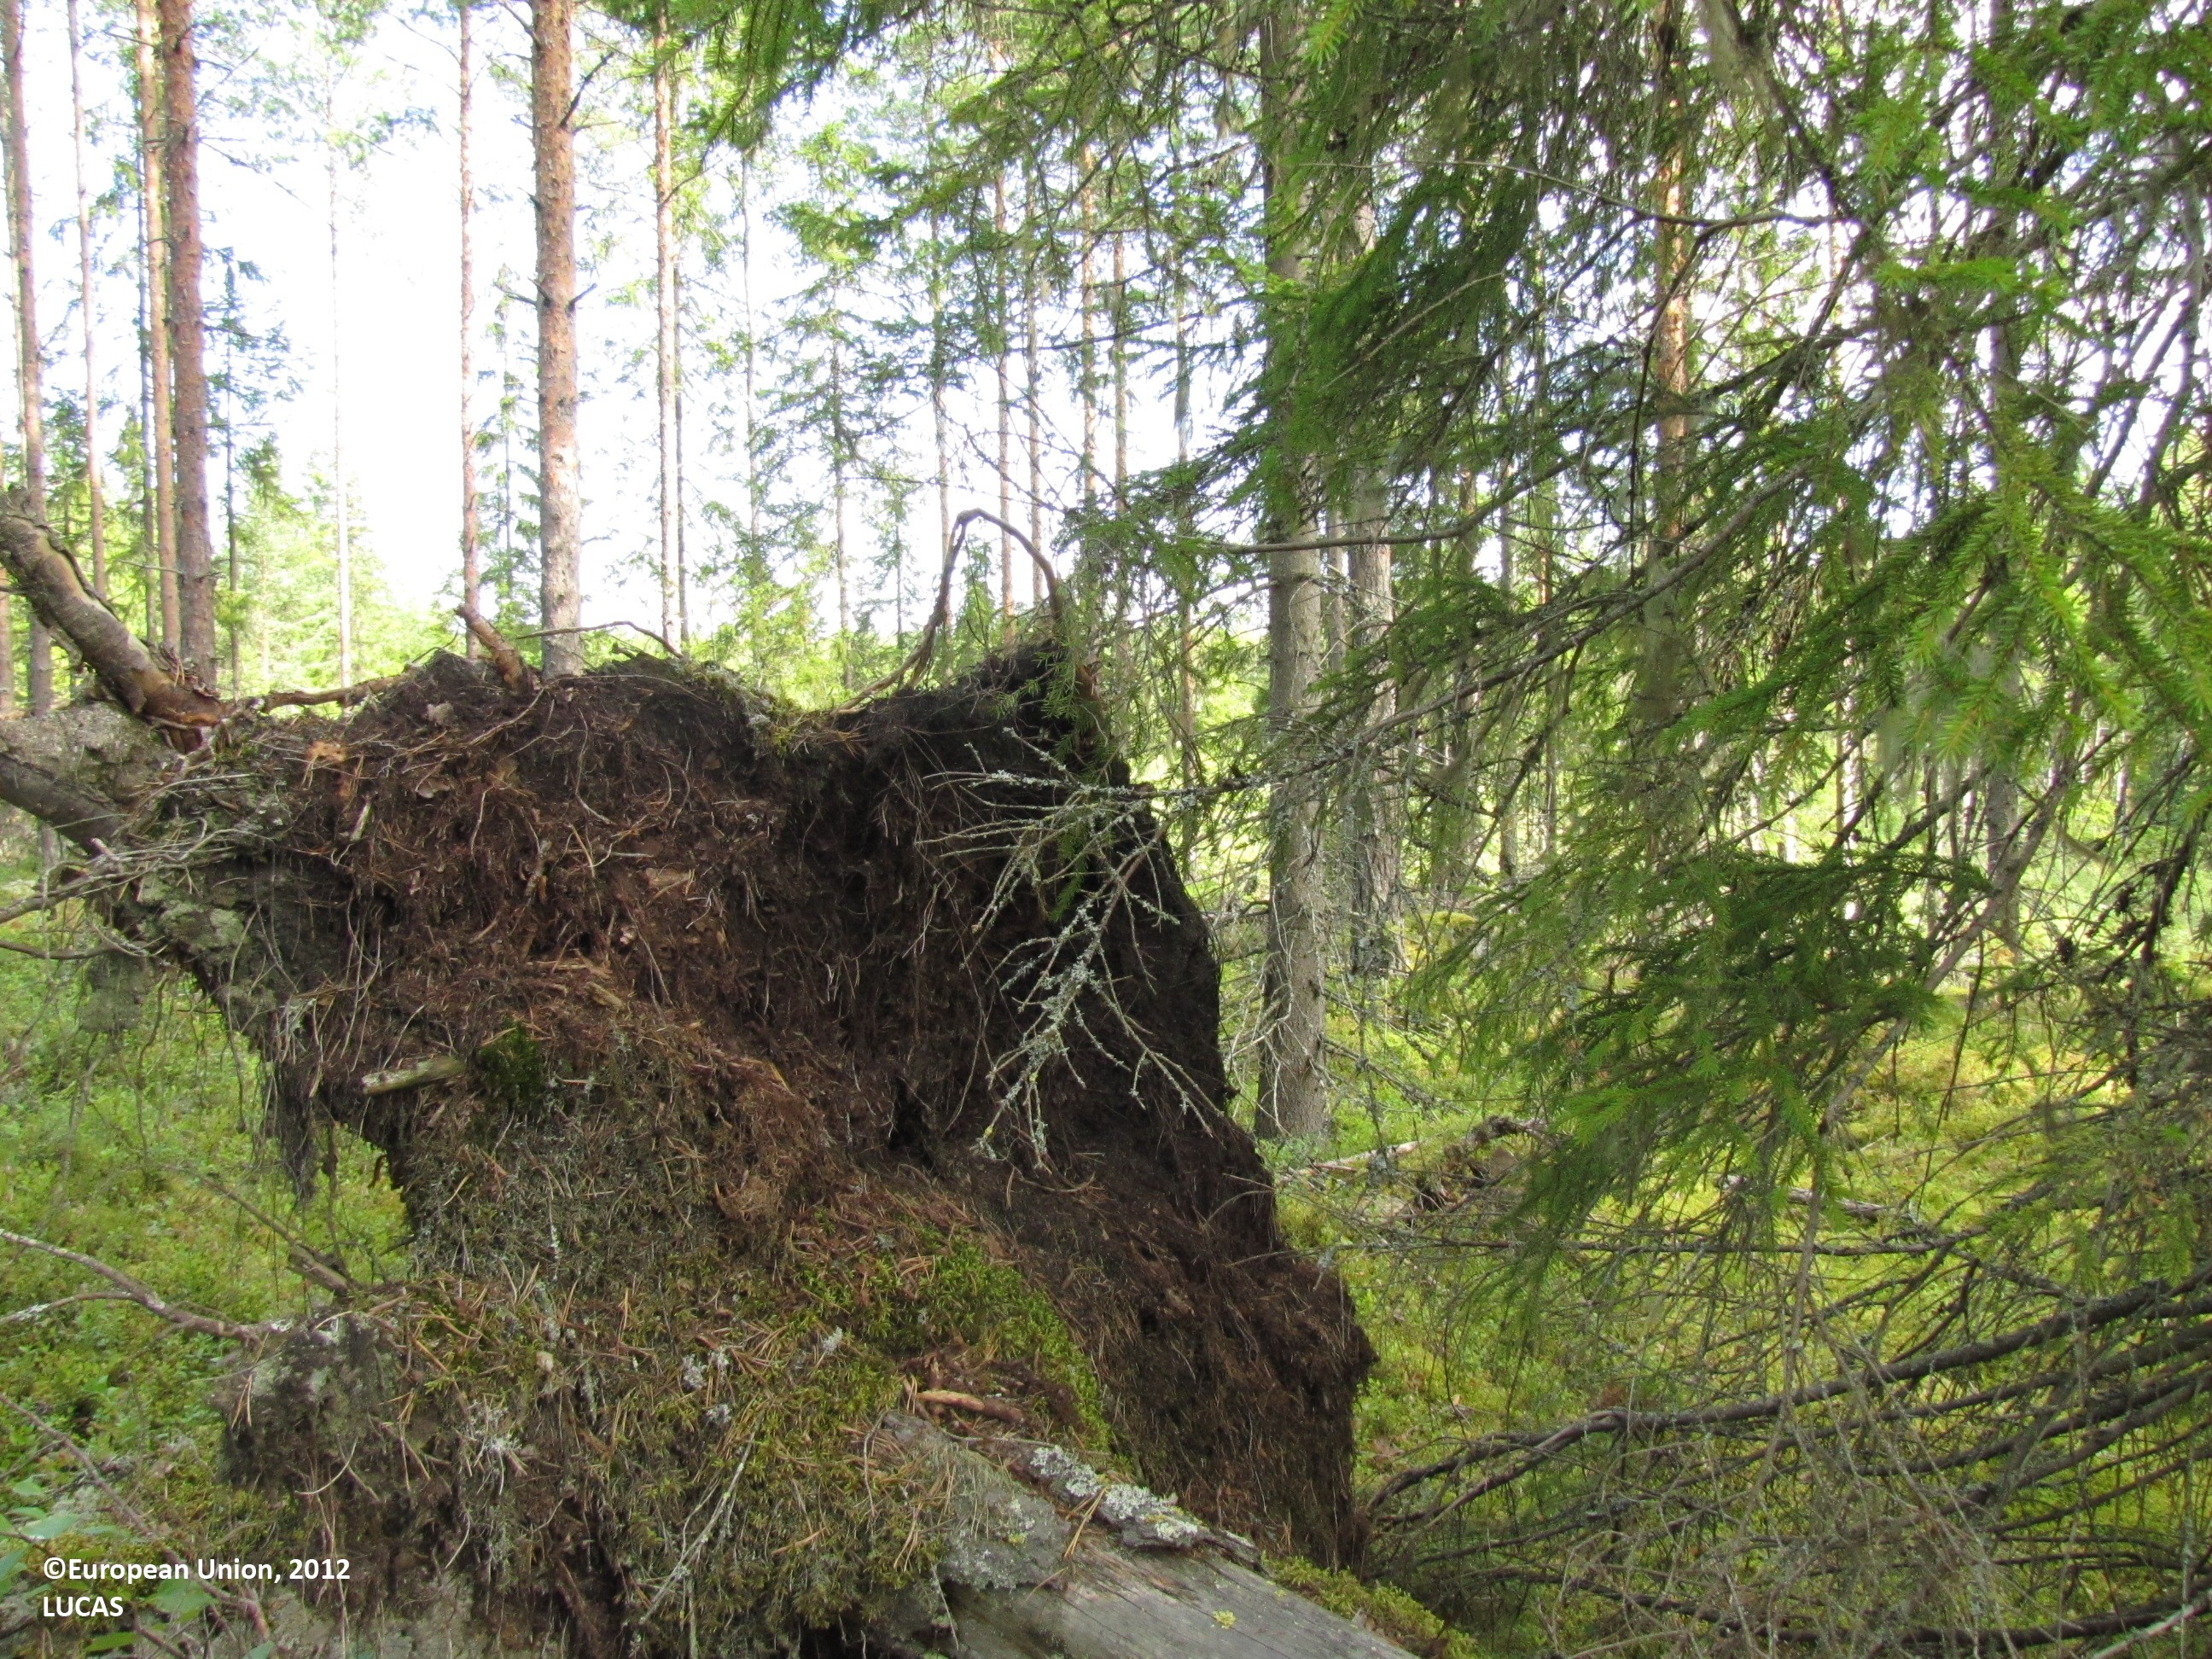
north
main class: Woodland
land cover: Other coniferous woodland
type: boreal forest
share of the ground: 50 - 75 %
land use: Forestry
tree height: > 5 m
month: August
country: FI
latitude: 61.8062
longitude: 23.2208
